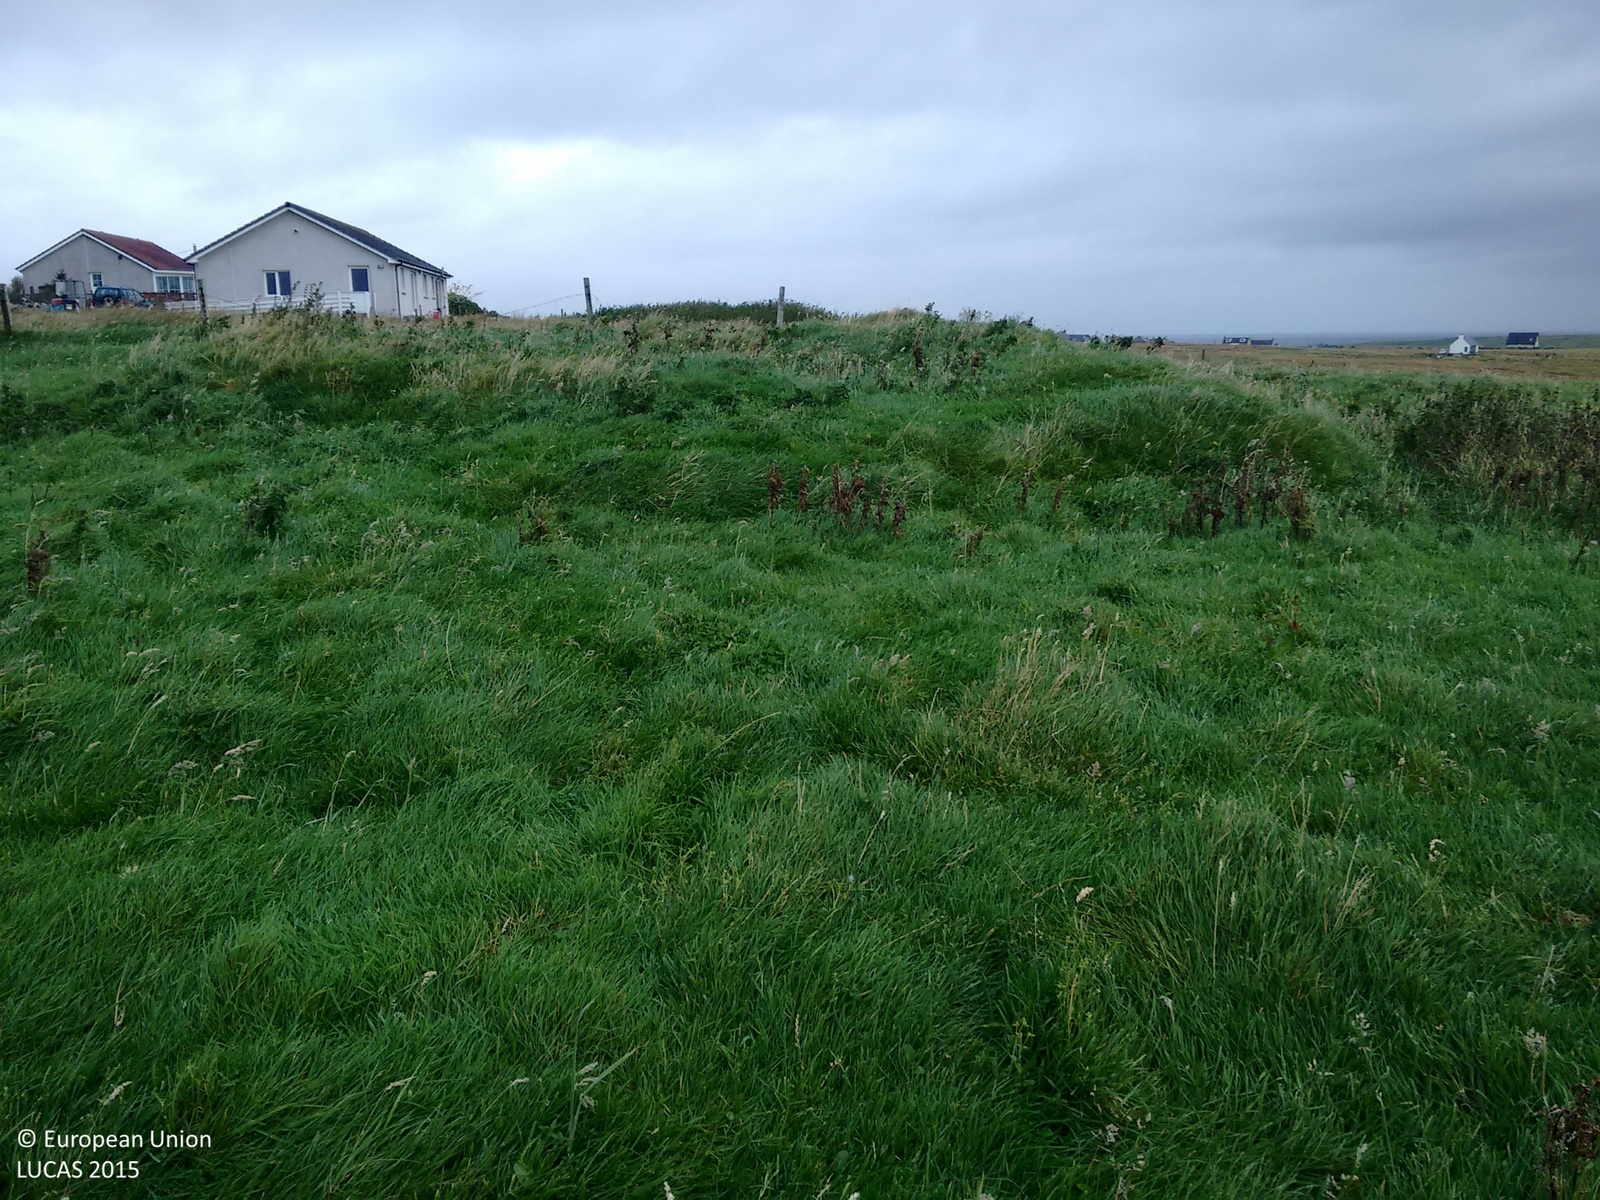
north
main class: Grassland
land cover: Grassland without tree/shrub cover
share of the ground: > 75 %
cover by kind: herbaceous plants 100 %
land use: Agriculture (excluding fallow land and kitchen gardens)
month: October
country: GB
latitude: 58.2442
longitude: -6.1585
